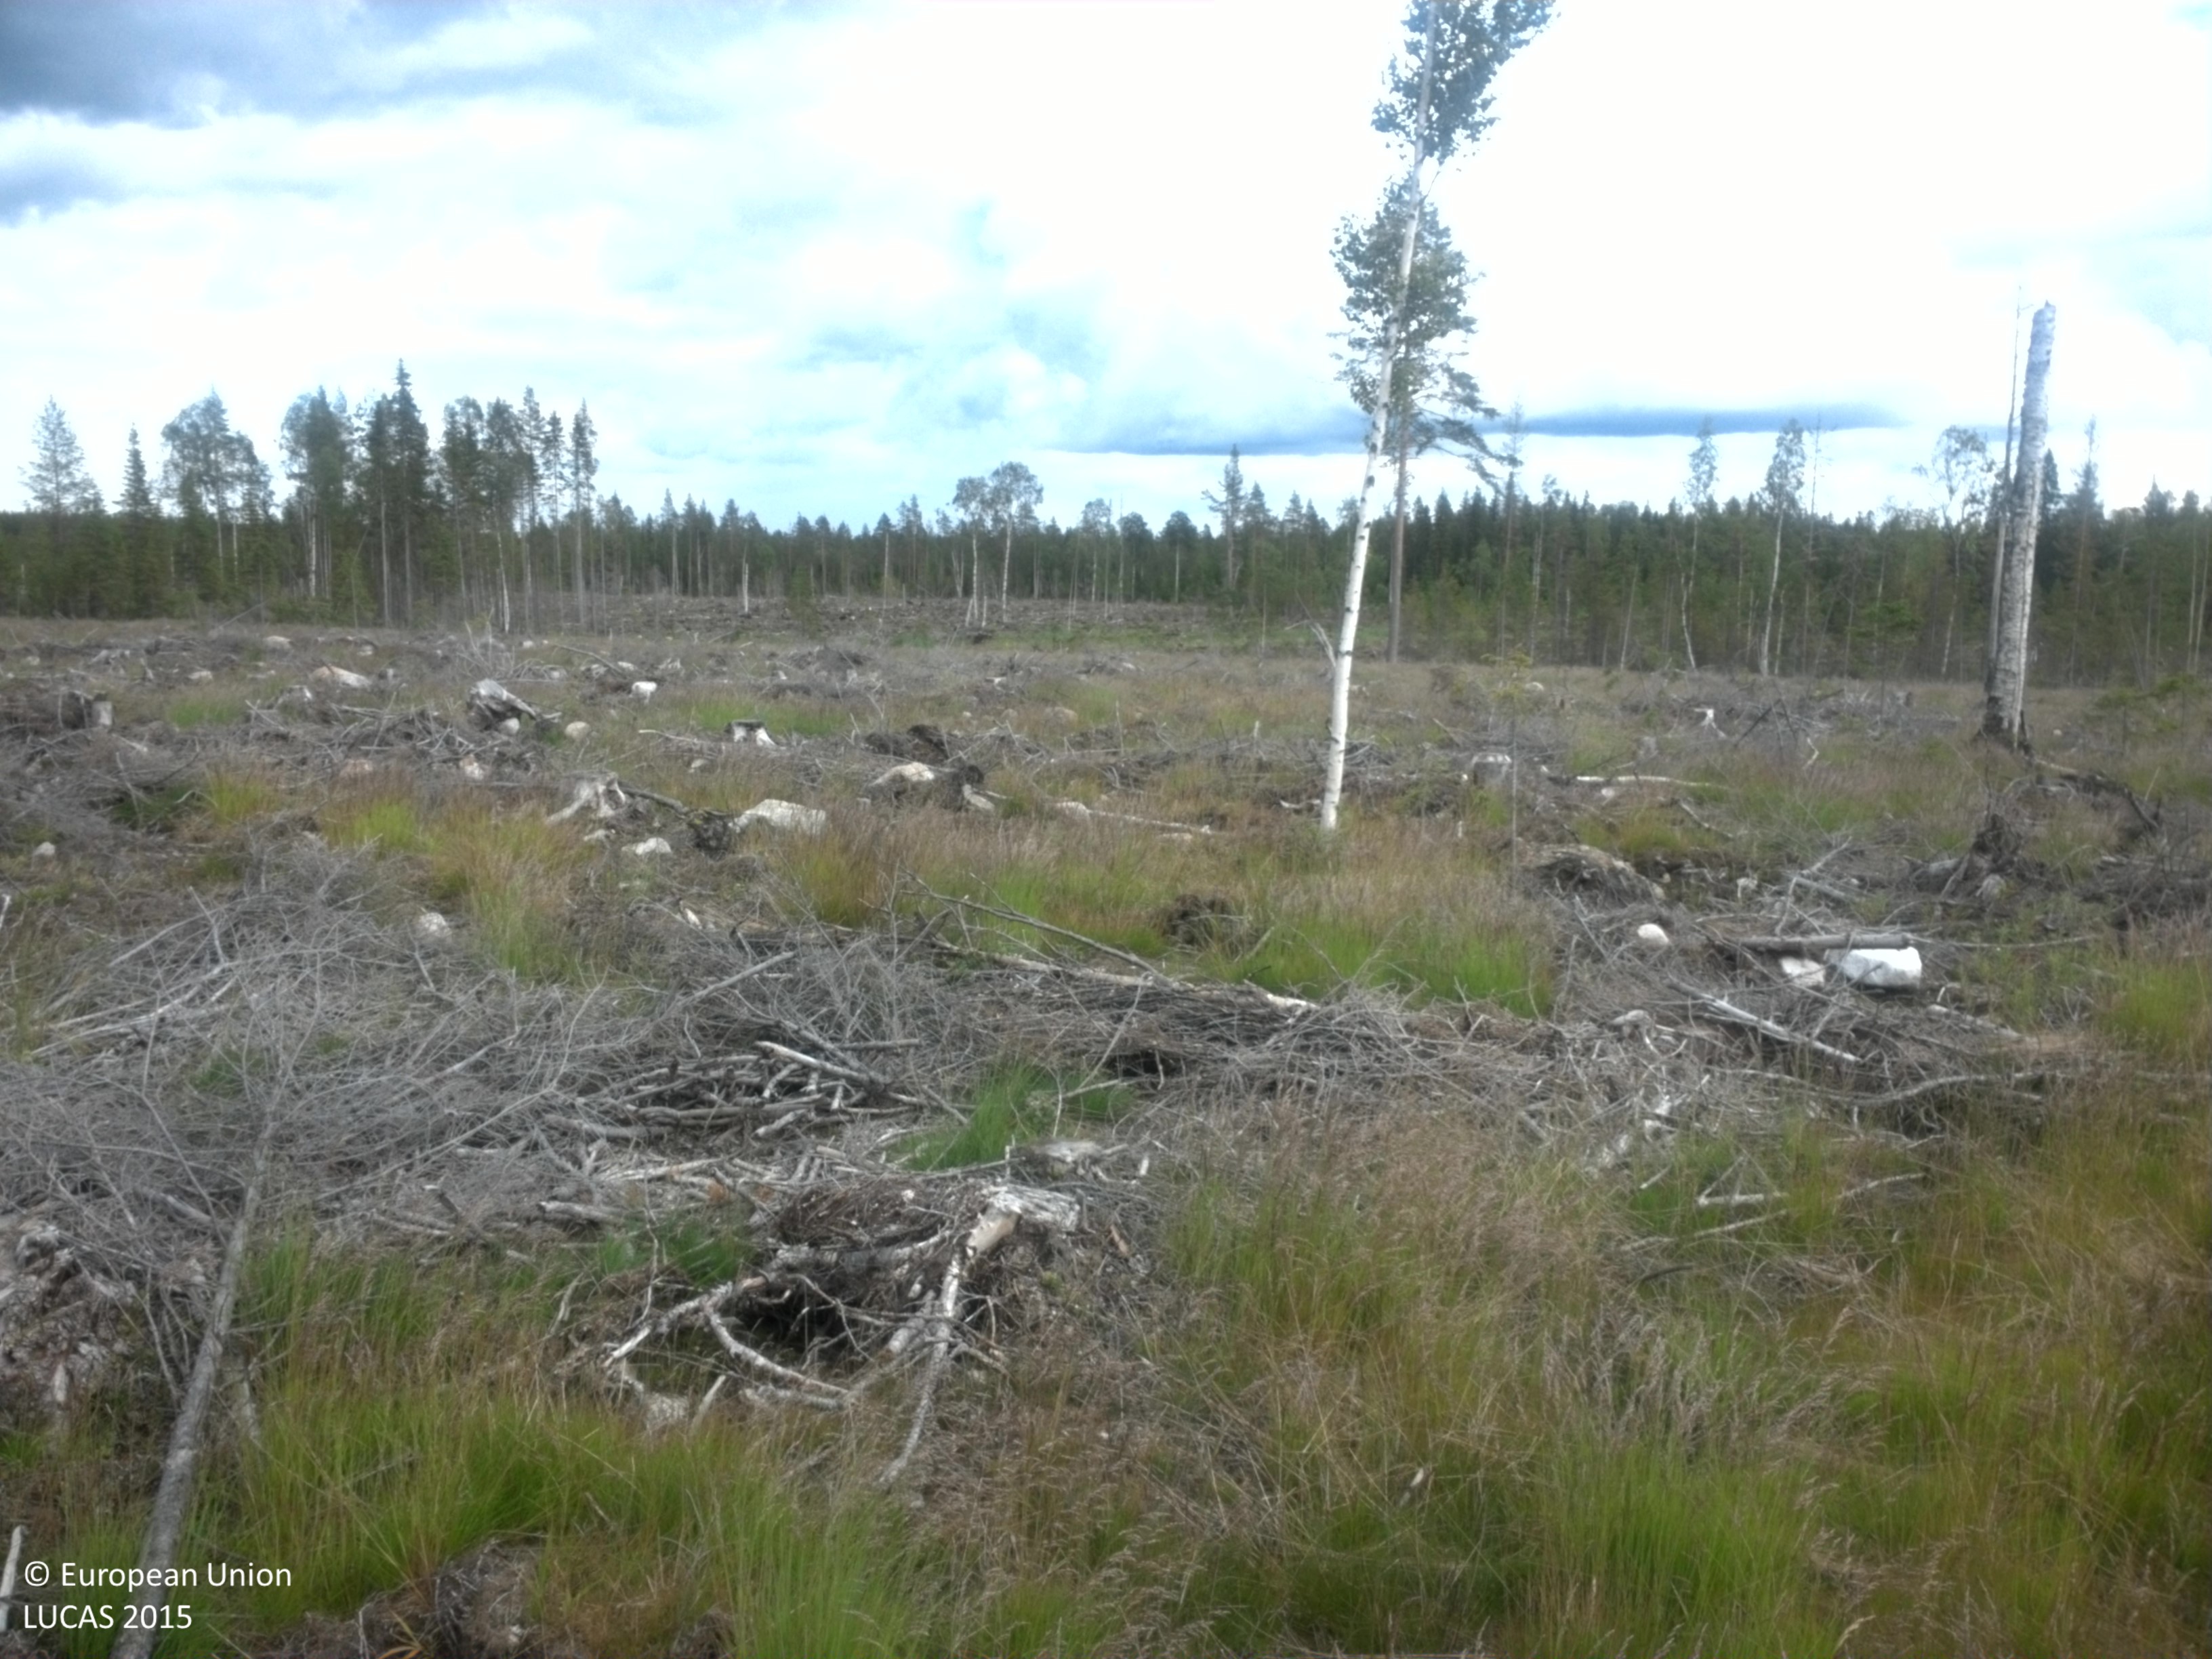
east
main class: Grassland
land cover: Grassland with sparse tree/shrub cover
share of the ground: > 75 %
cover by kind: herbaceous plants 65 %, unconsolidated bare surface 20 %, broadleaved forest trees 5 %, shrubs 5 %, consolidated bare surface 5 %
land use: Forestry
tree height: > 5 m
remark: Clear cut
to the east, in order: Grassland with sparse tree/shrub cover; Ditches and canals; Grassland with sparse tree/shrub cover; Ditches and canals; Grassland with sparse tree/shrub cover
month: July
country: SE
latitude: 64.6975
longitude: 20.3544
